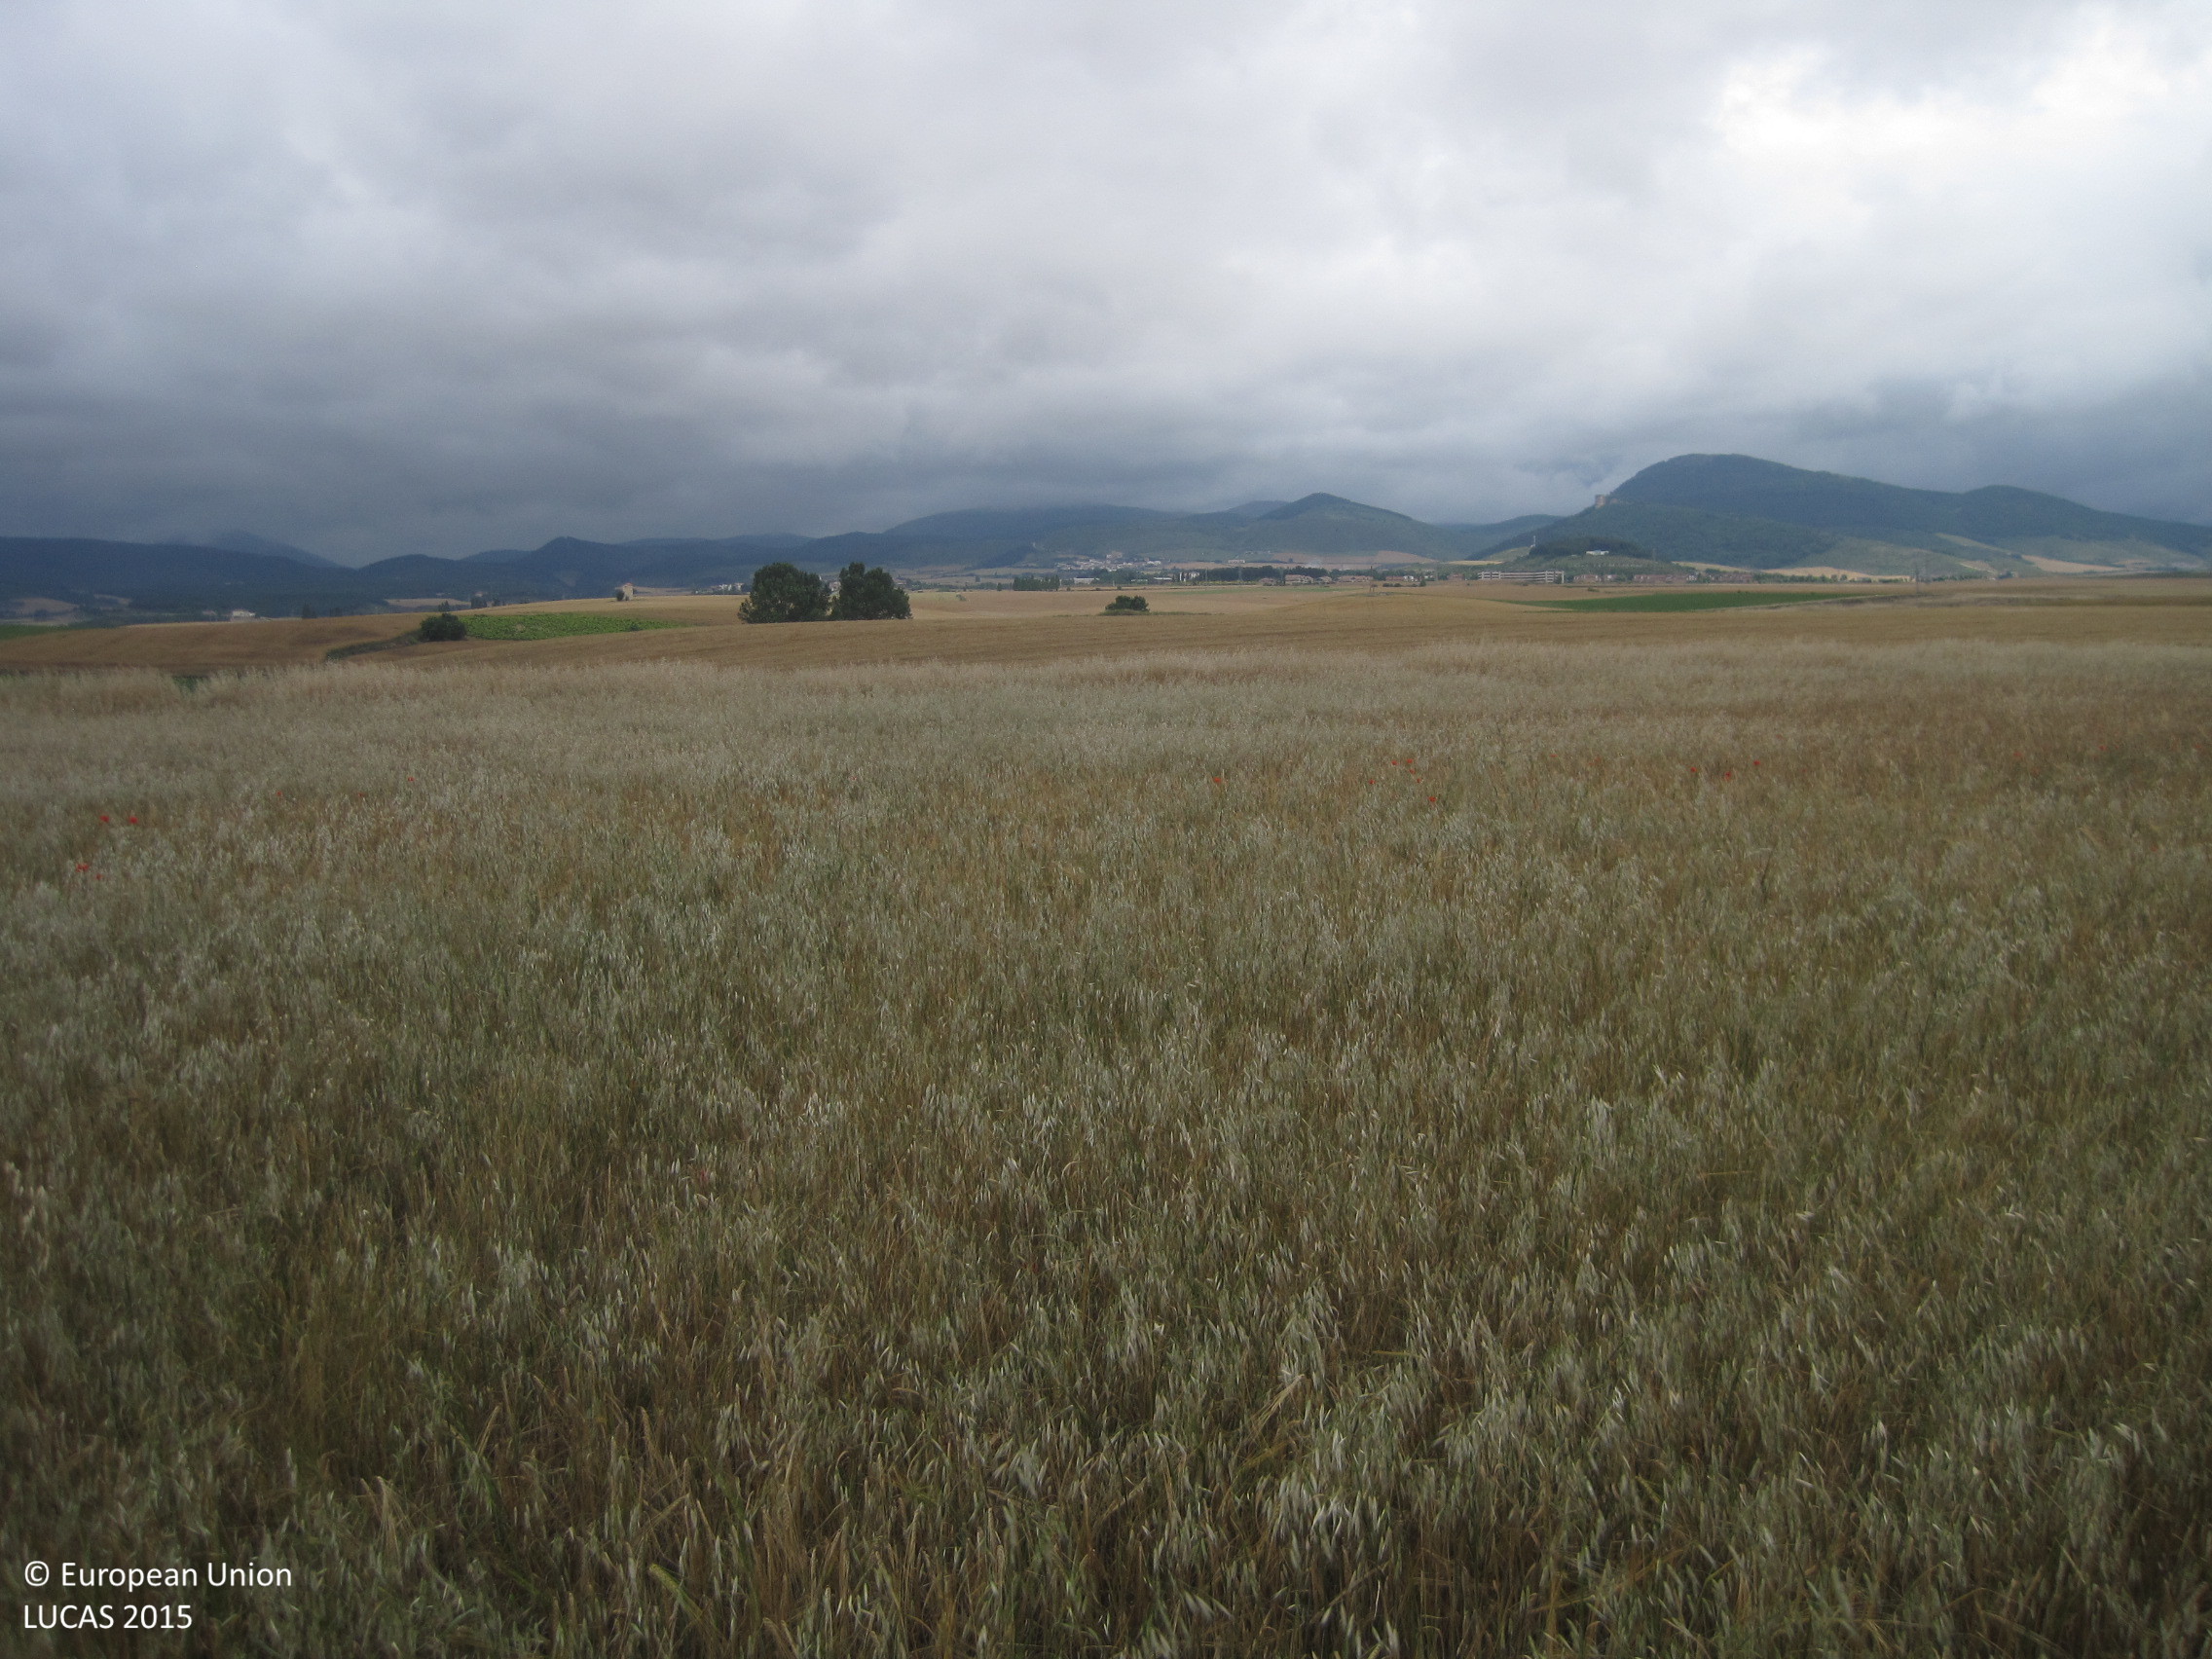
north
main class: Cropland
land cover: Mixed cereals for fodder
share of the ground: > 75 %
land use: Agriculture (excluding fallow land and kitchen gardens)
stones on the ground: < 10 %
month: June
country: ES
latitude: 42.8247
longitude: -1.7463
